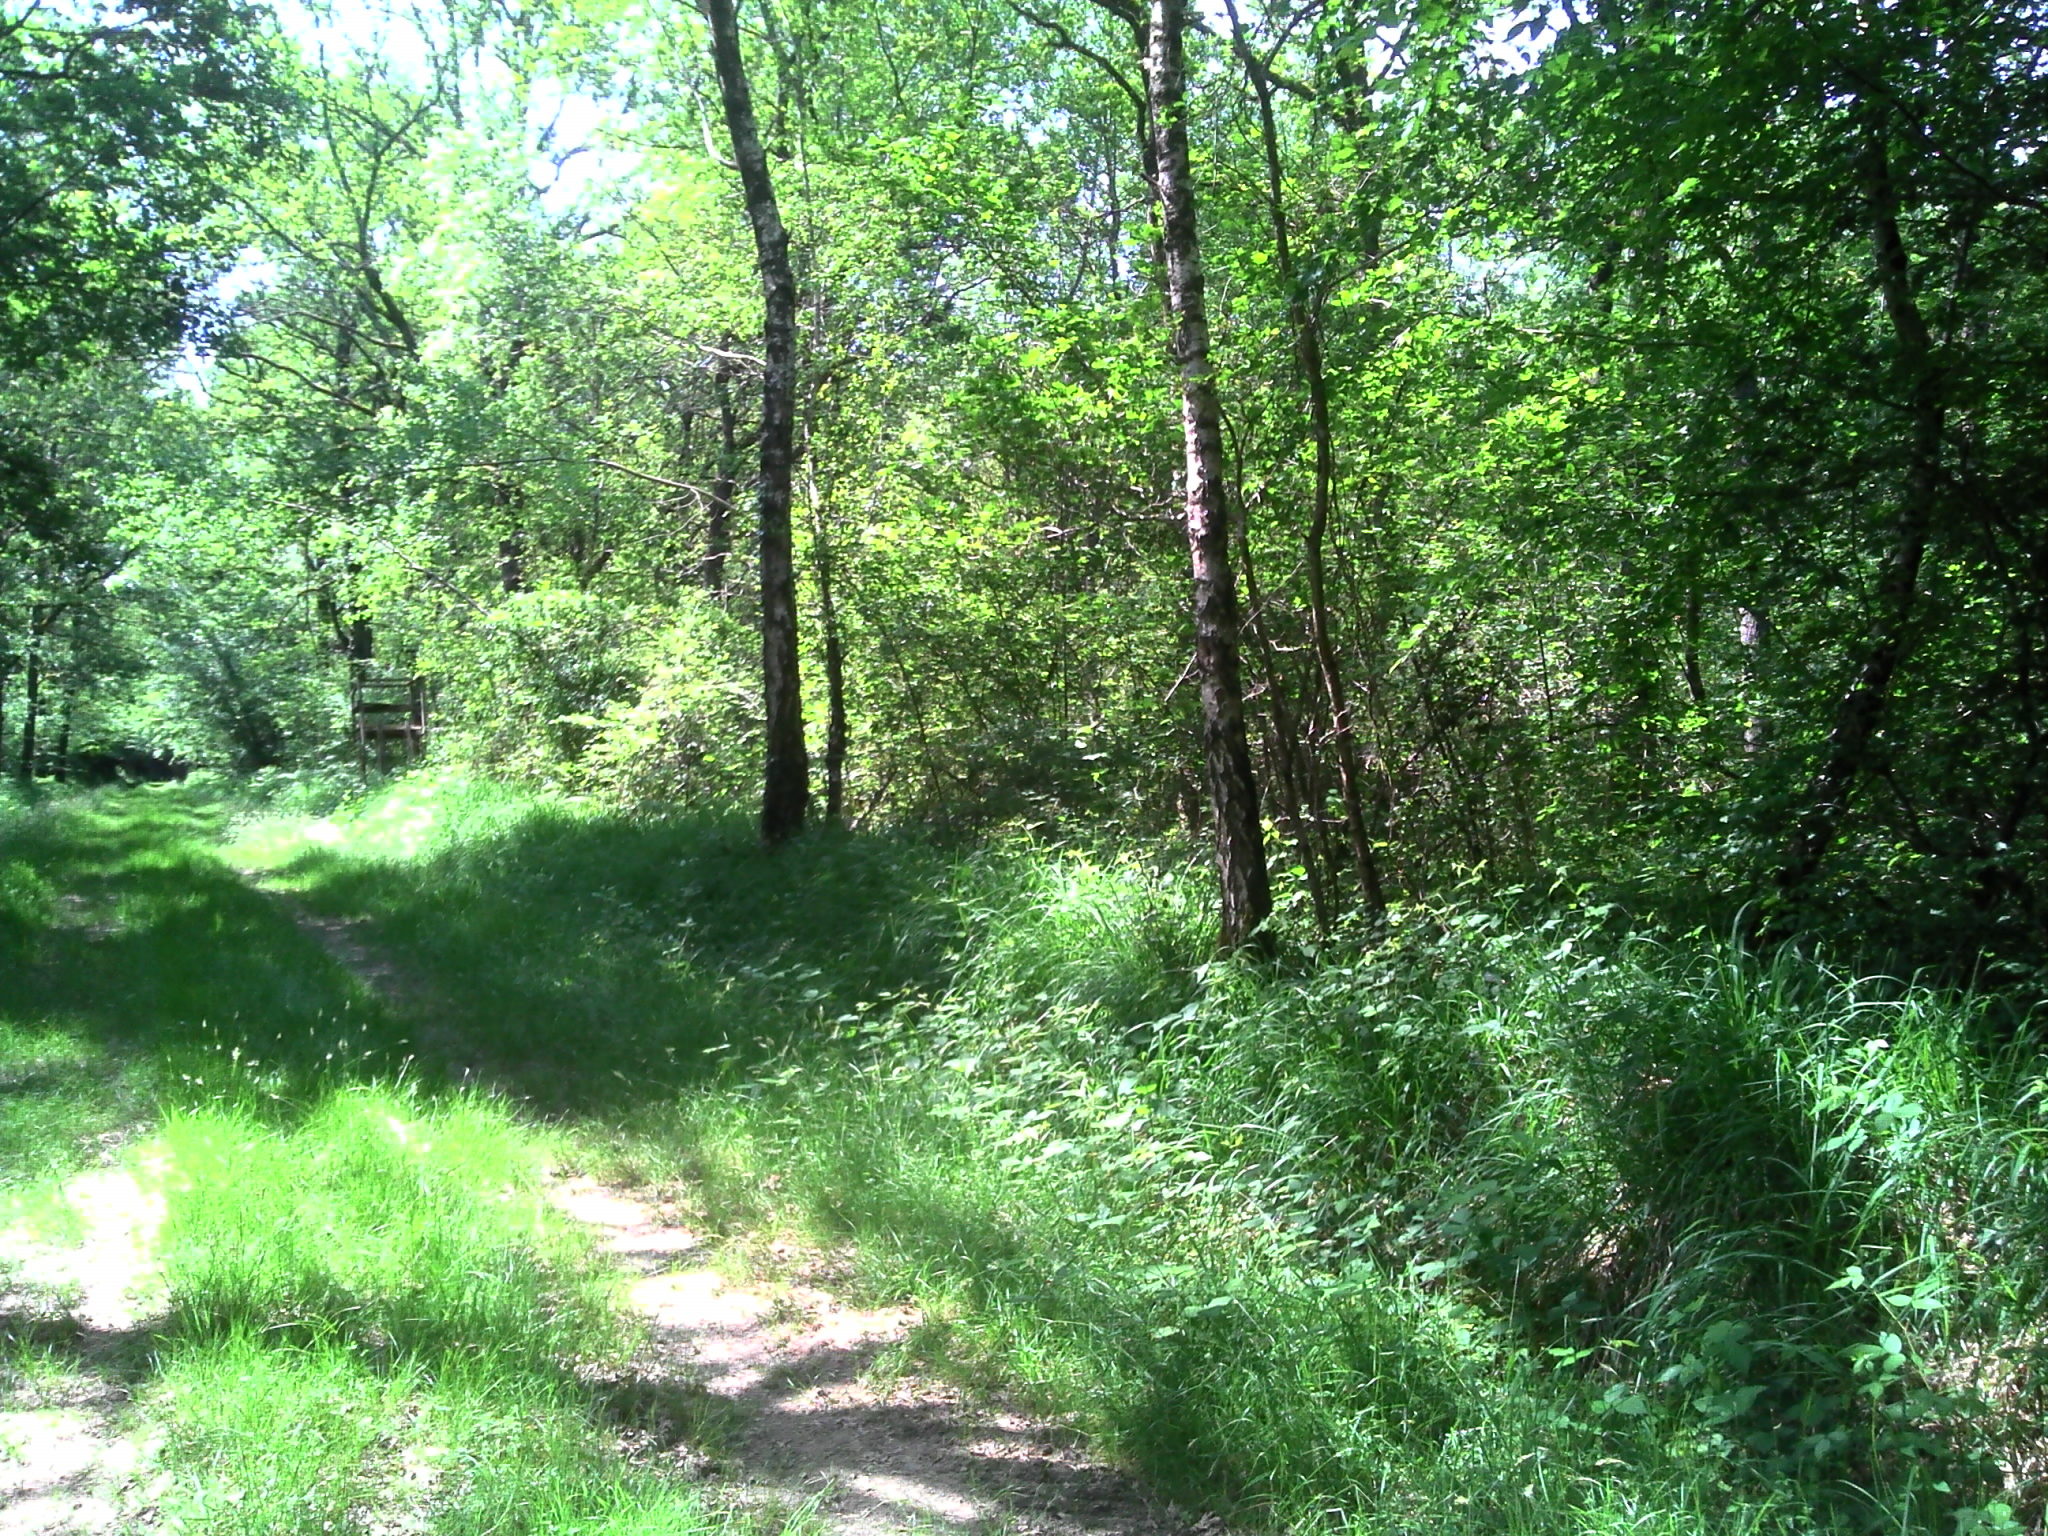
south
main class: Woodland
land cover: Broadleaved woodland
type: mesophytic deciduous forest
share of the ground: > 75 %
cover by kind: broadleaved forest trees 80 %, herbaceous plants 20 %
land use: Forestry
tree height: > 5 m
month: May
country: FR
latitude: 46.5654
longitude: 5.1360
